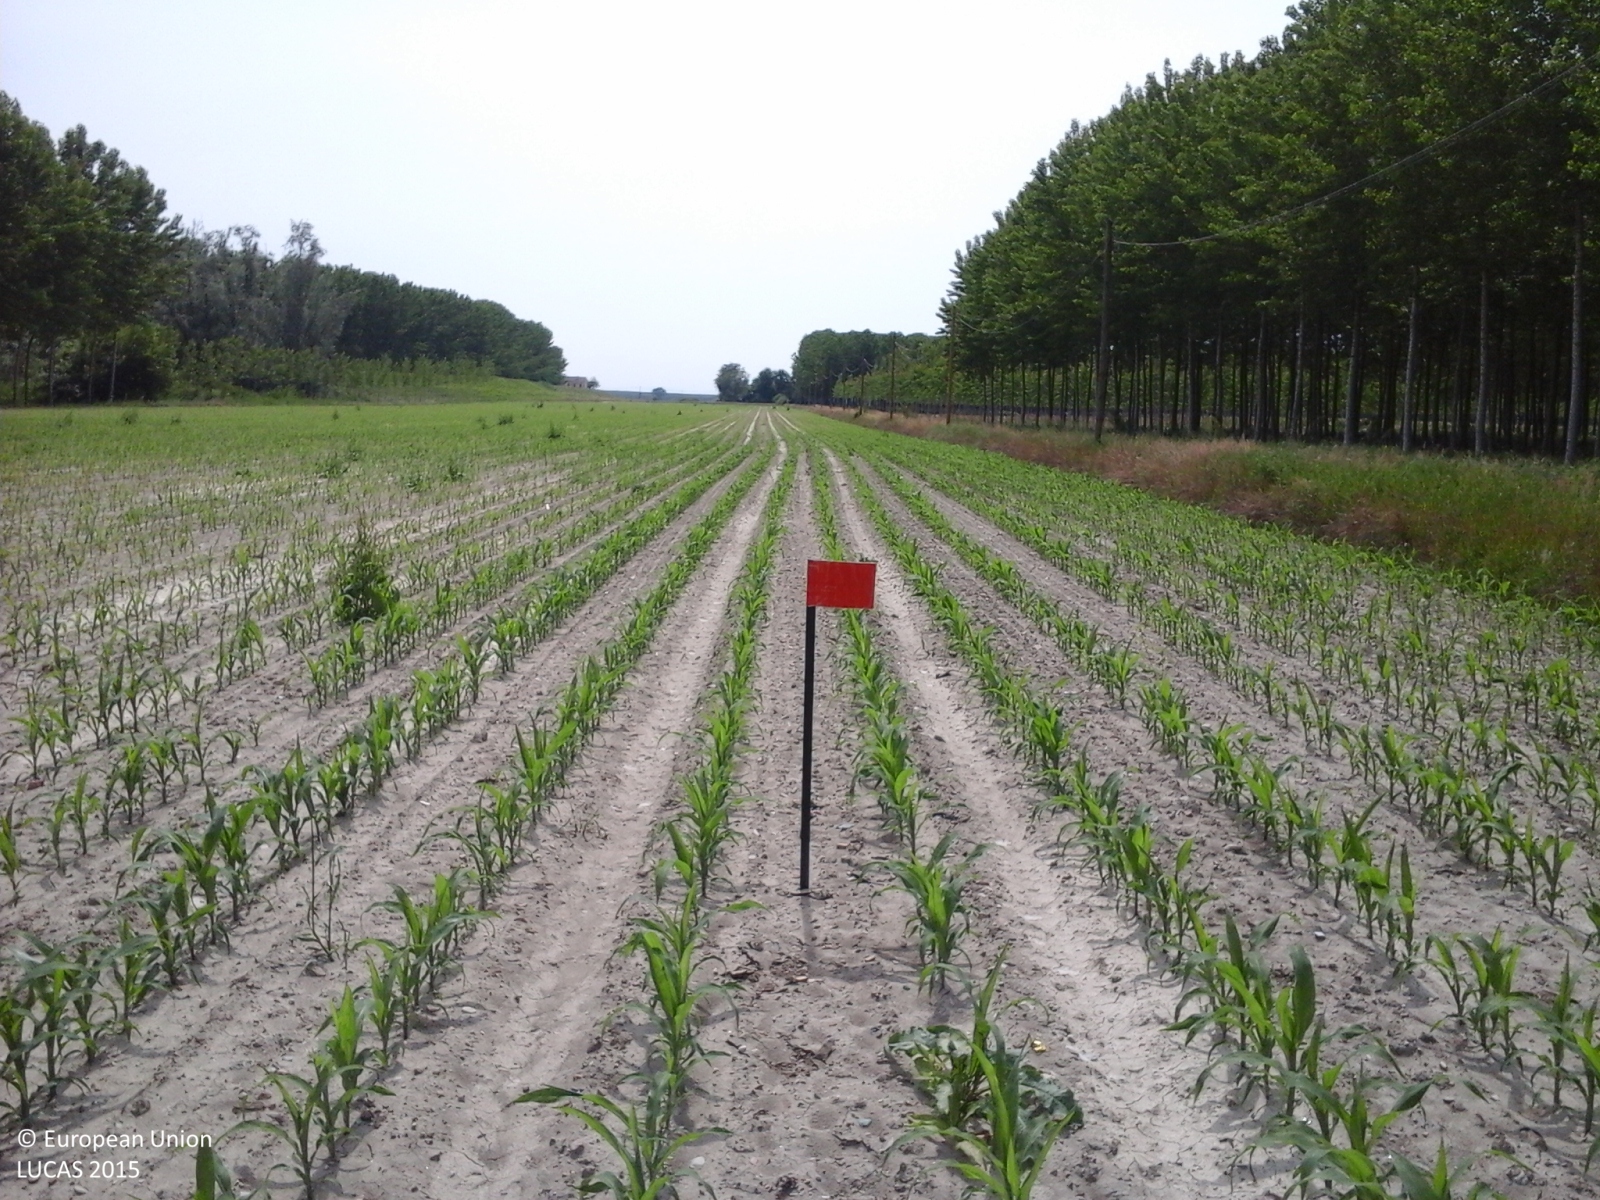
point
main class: Cropland
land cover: Maize
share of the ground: < 10 %
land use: Agriculture (excluding fallow land and kitchen gardens)
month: May
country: IT
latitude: 44.9990
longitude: 10.3925
